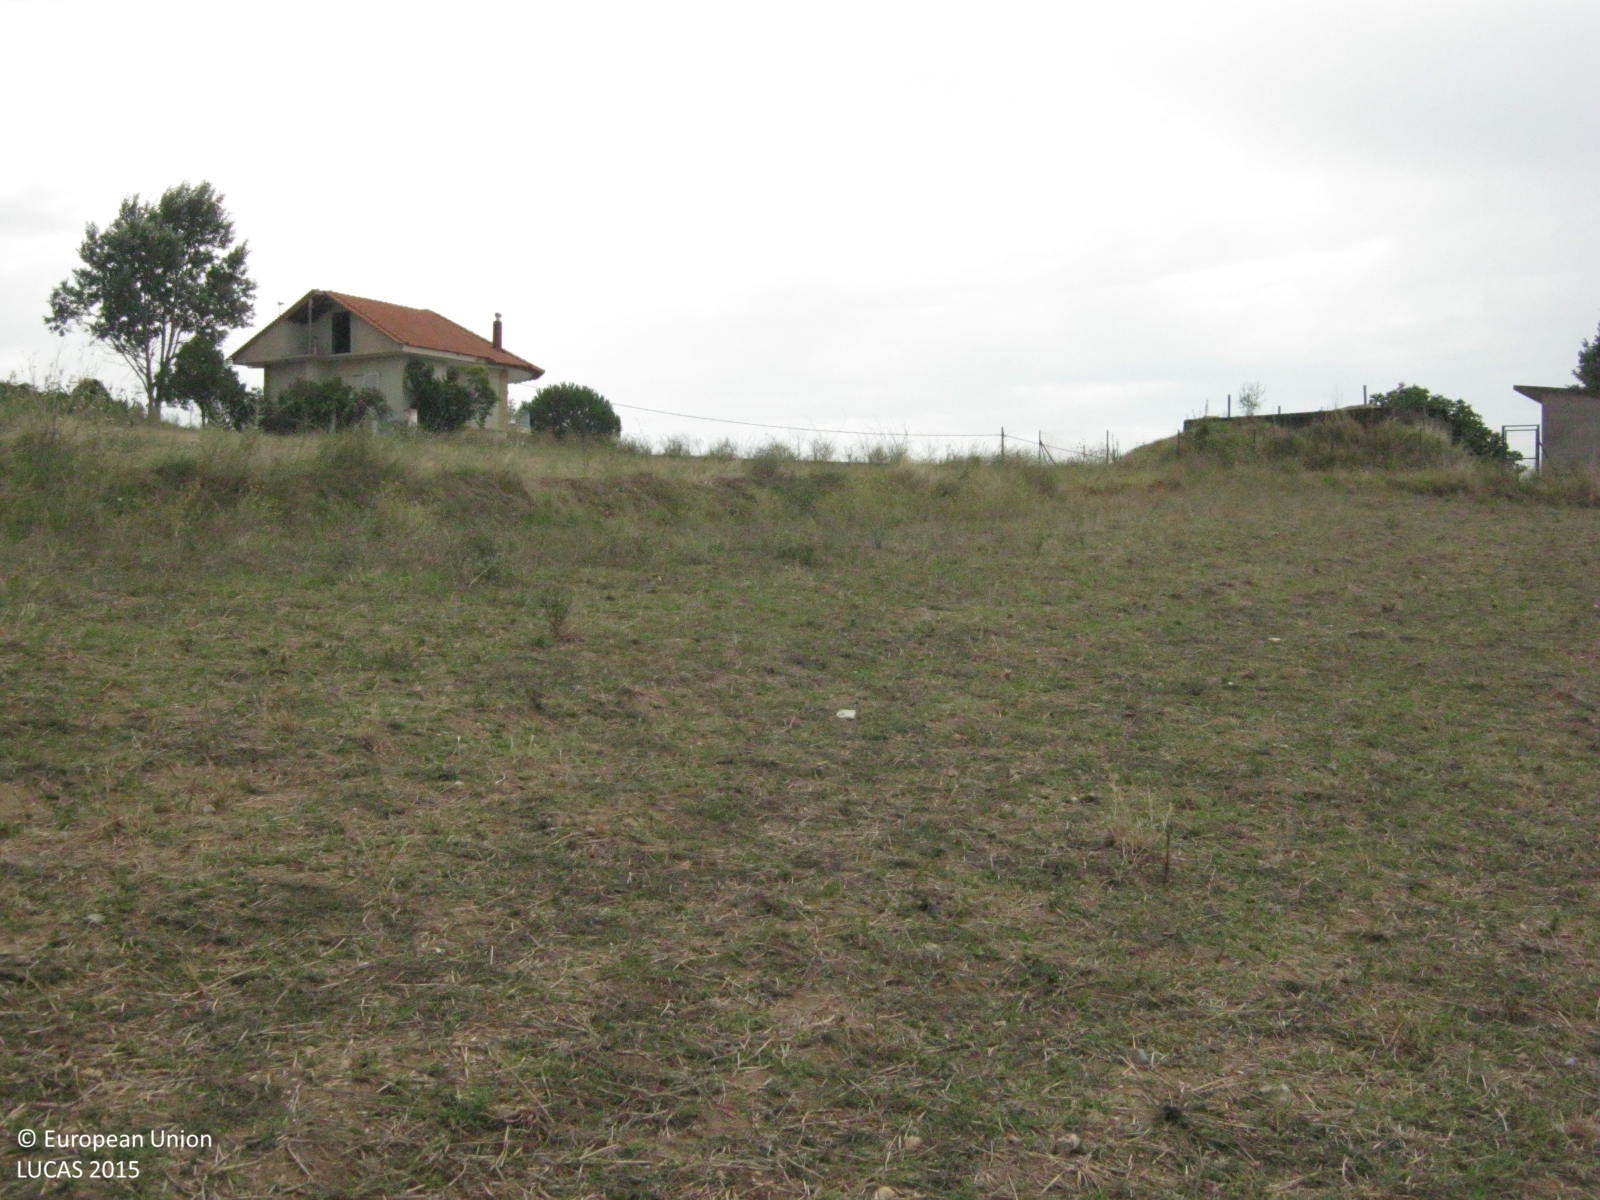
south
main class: Grassland
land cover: Spontaneously vegetated surfaces
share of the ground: > 75 %
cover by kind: herbaceous plants 90 %, consolidated bare surface 10 %
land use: Agriculture (excluding fallow land and kitchen gardens)
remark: Harvested field
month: August
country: GR
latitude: 40.9004
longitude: 22.9853
